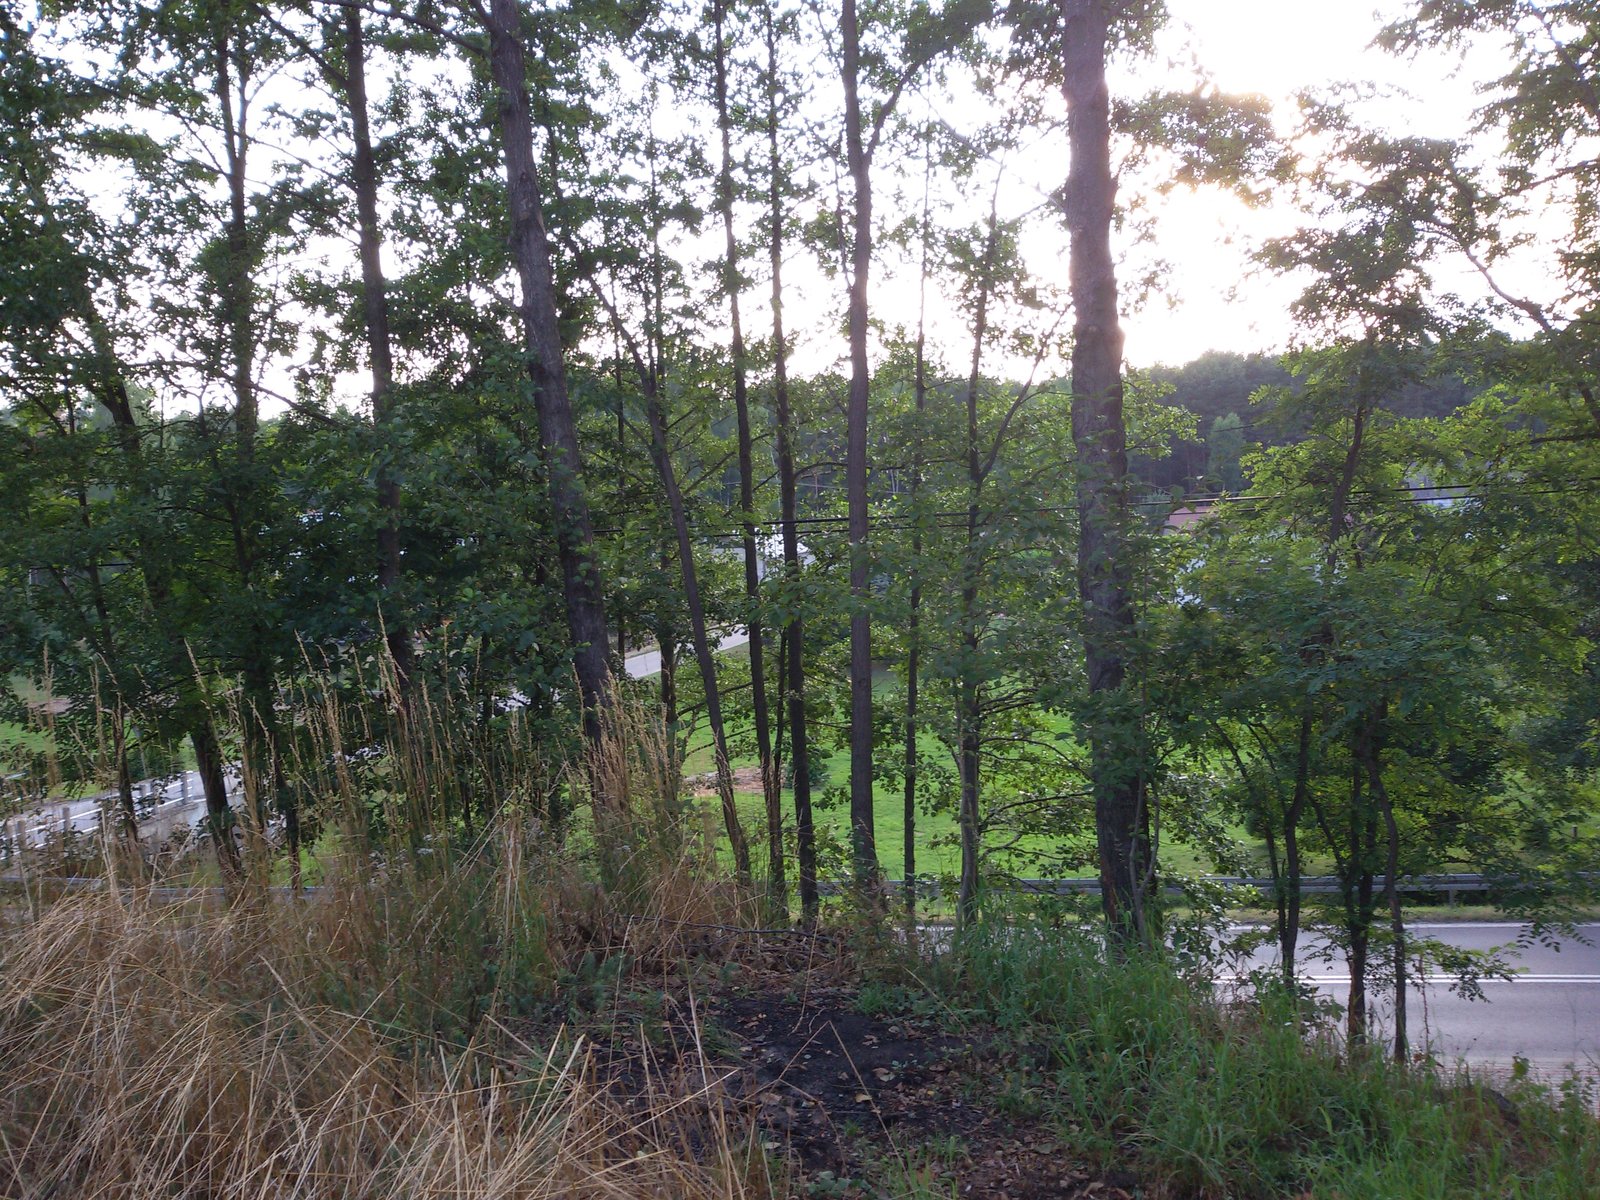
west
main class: Grassland
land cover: Grassland with sparse tree/shrub cover
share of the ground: 50 - 75 %
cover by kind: herbaceous plants 95 %, coniferous forest trees 5 %
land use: Residential
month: July
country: PL
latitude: 50.2158
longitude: 22.3820
